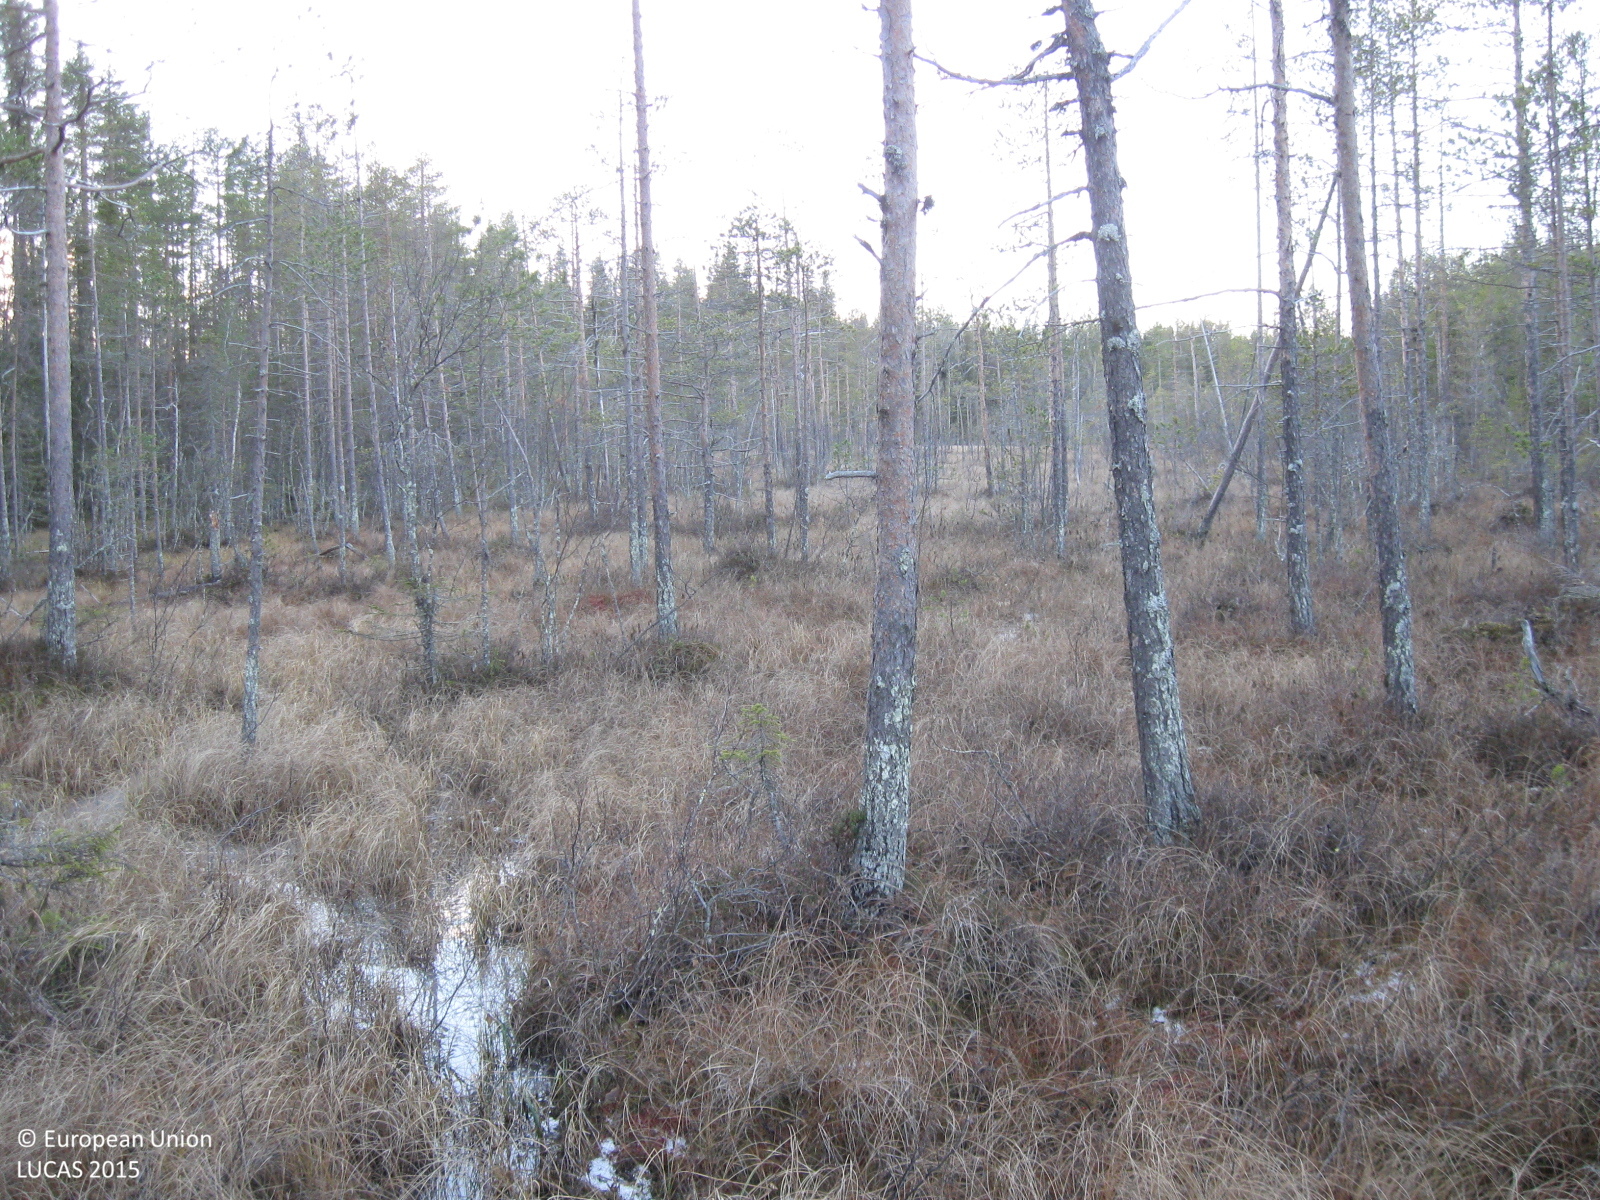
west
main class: Woodland
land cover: Pine dominated coniferous woodland
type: mire and swamp forests
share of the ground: 25 - 50 %
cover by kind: herbaceous plants 50 %, coniferous forest trees 30 %, shrubs 10 %, broadleaved forest trees 5 %, lichens and mosses 5 %
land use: Semi-natural and natural areas not in use
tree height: > 5 m
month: November
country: SE
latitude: 66.0381
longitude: 20.5312
